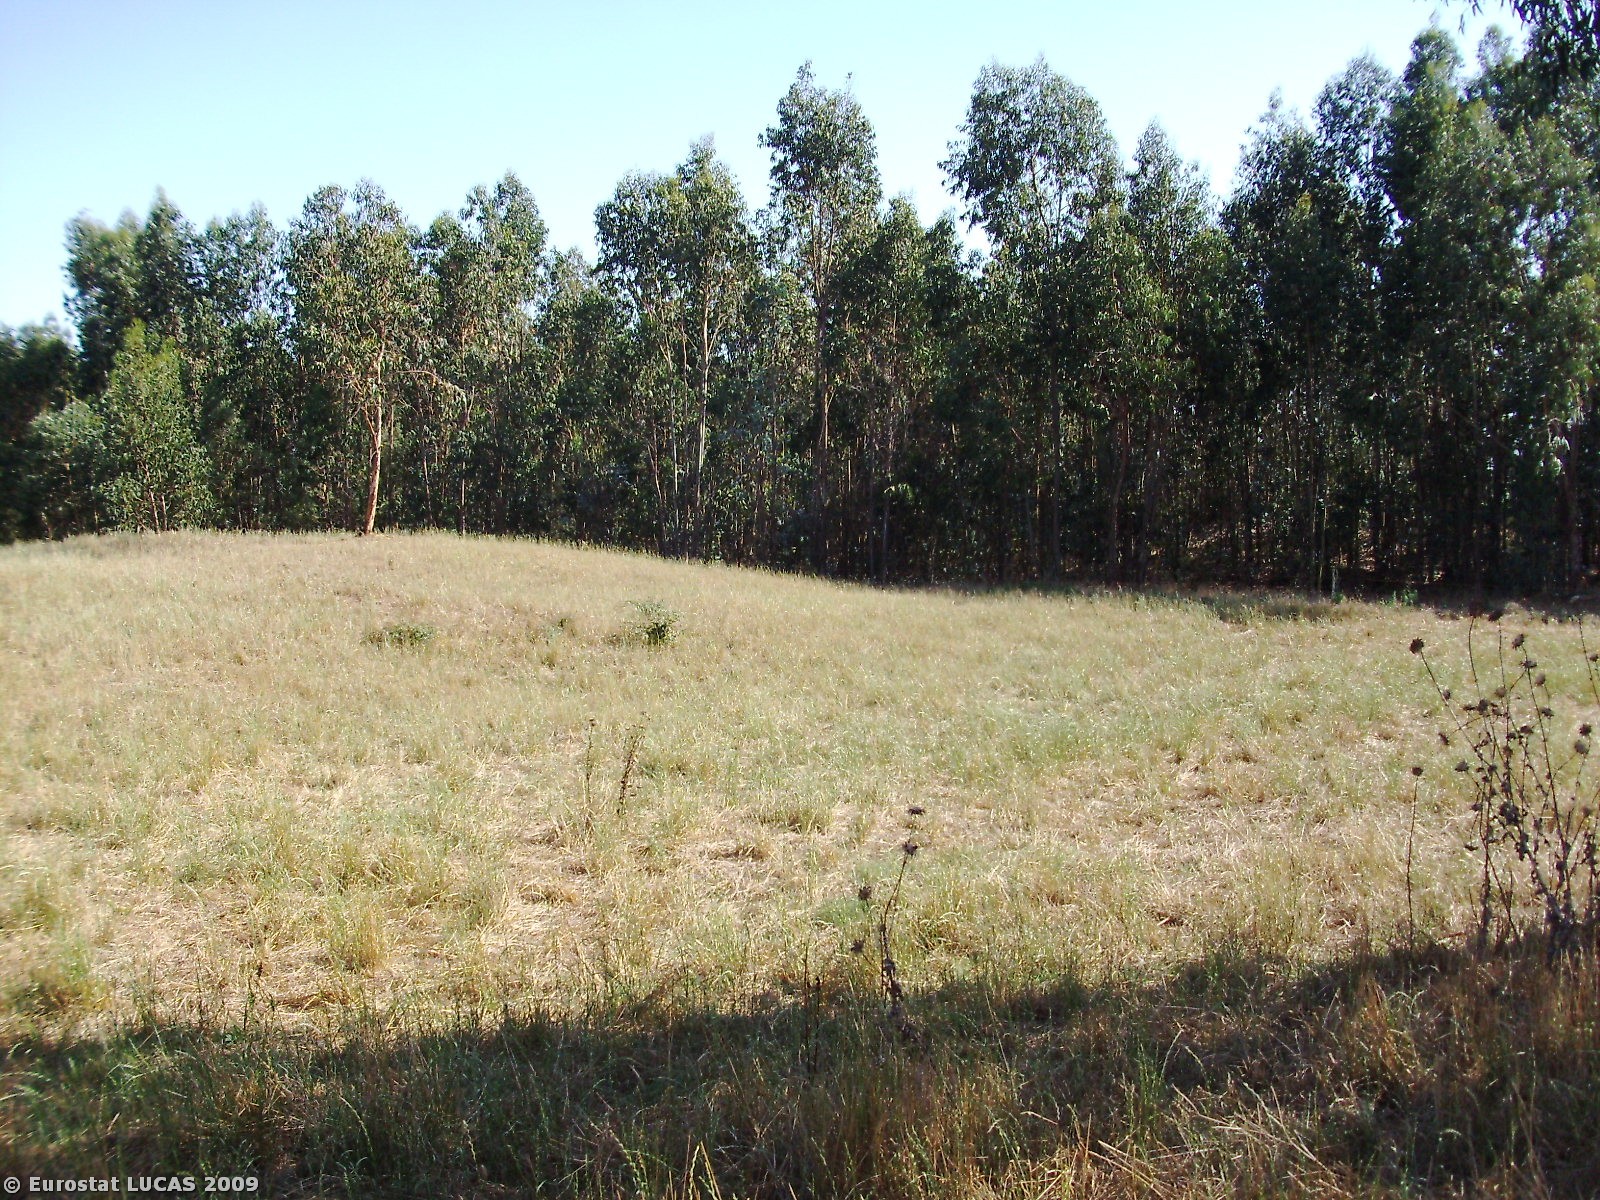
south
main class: Grassland
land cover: Grassland with sparse tree/shrub cover
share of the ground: > 75 %
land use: Agriculture (excluding fallow land and kitchen gardens)
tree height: > 5 m
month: July
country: PT
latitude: 39.3312
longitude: -8.8375
